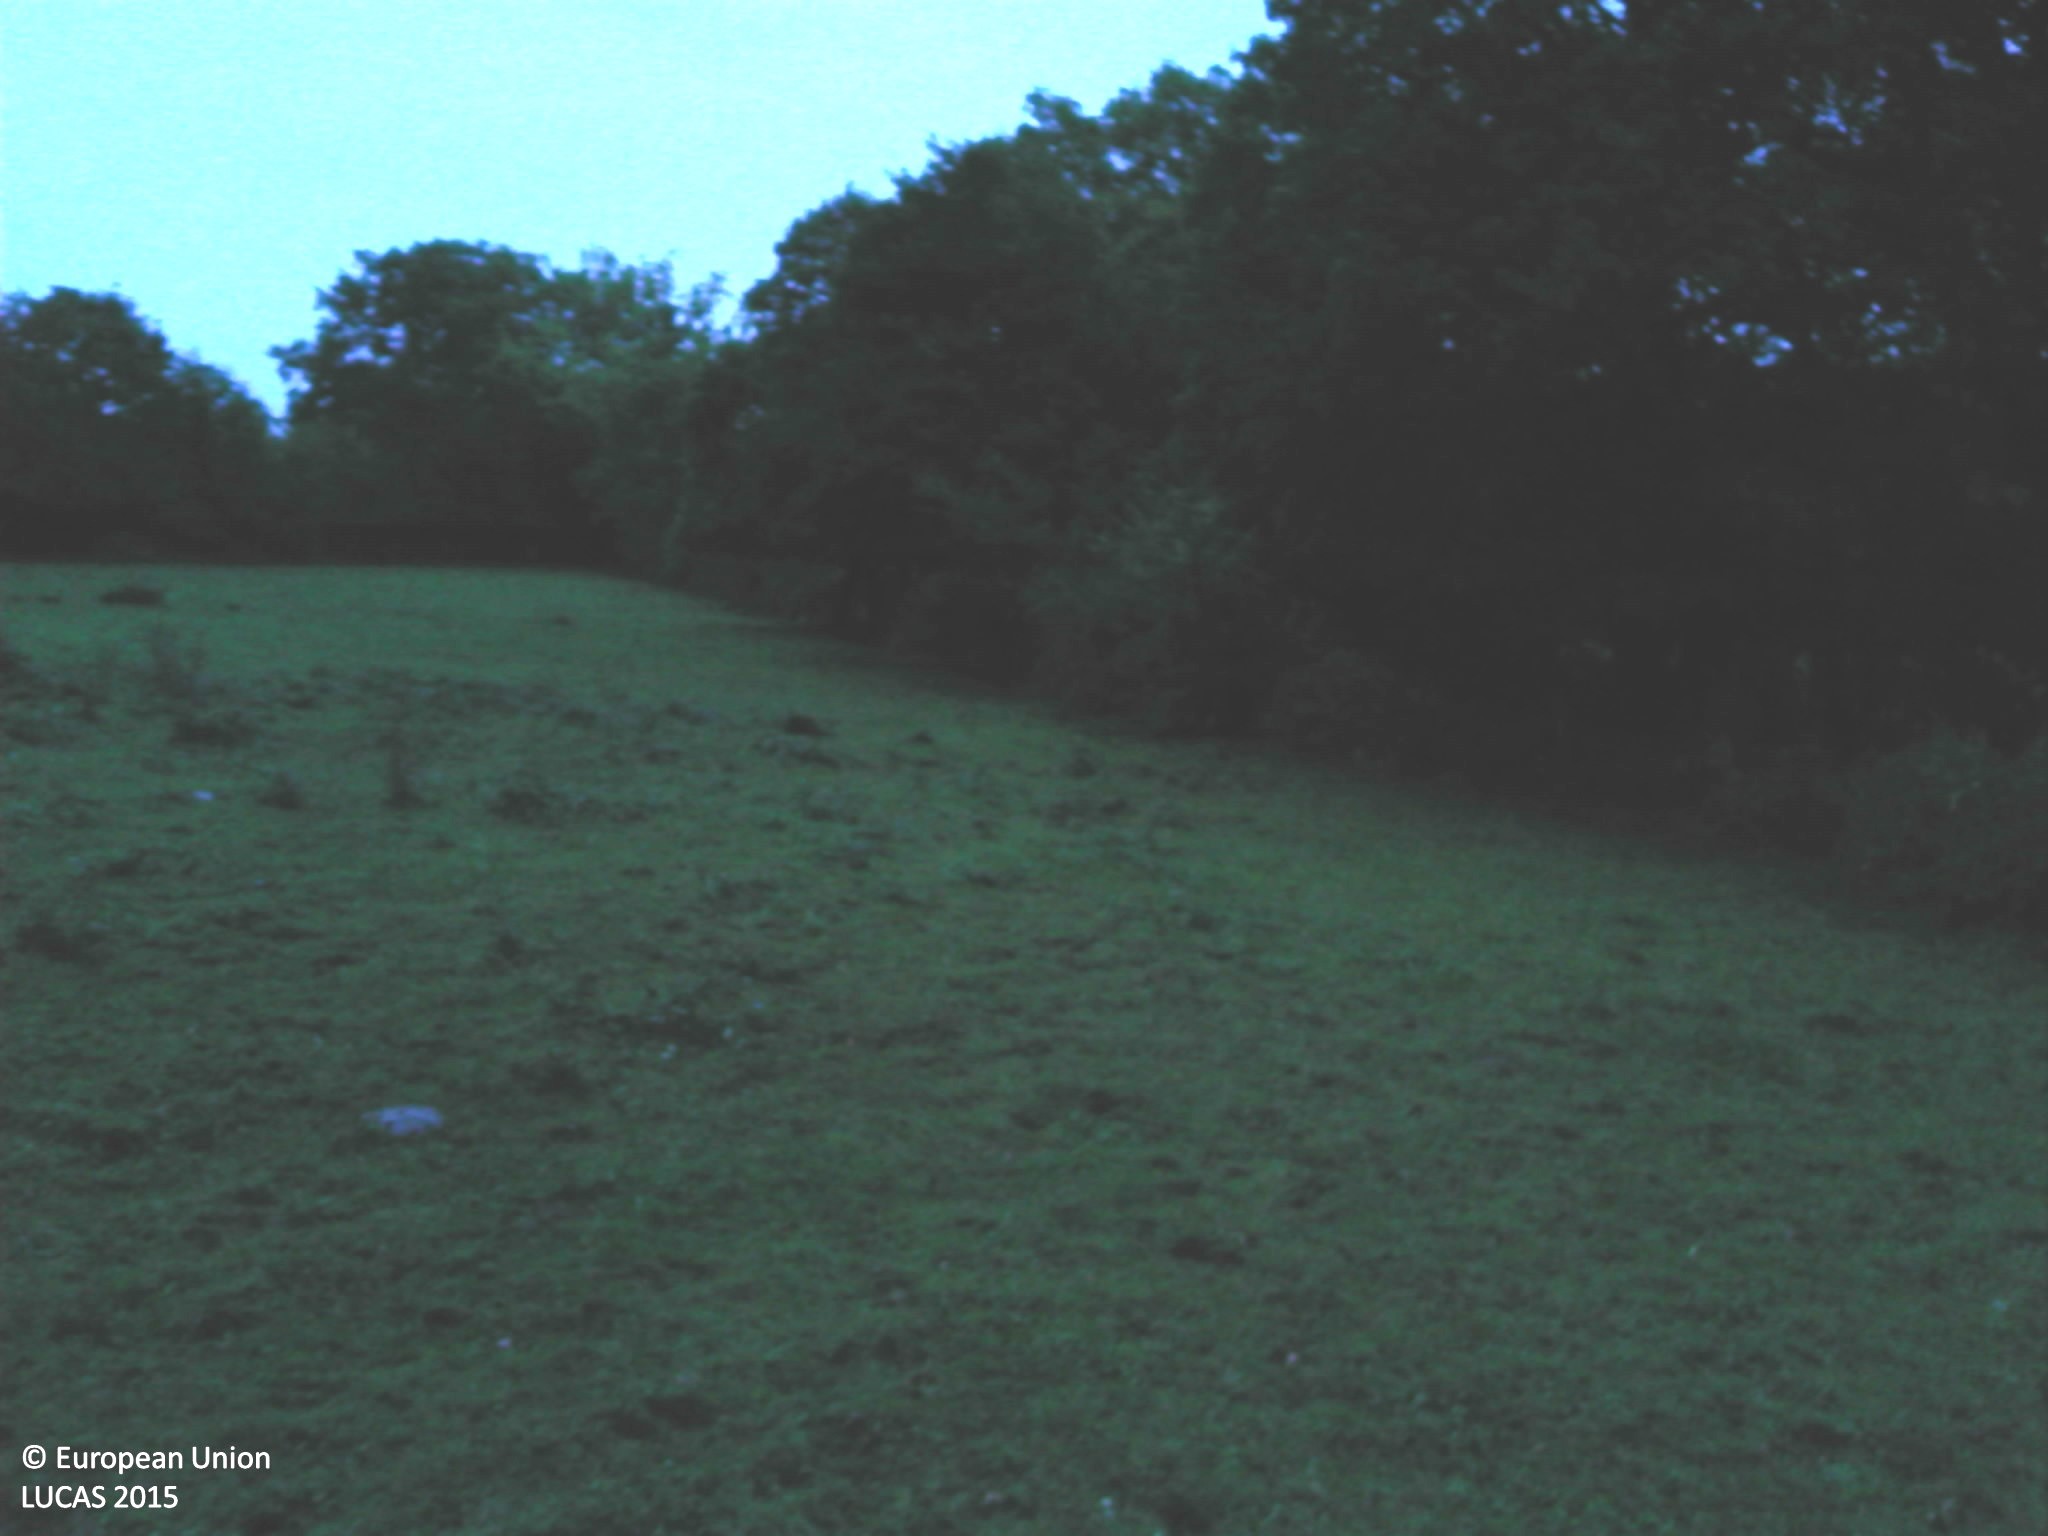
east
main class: Grassland
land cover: Grassland without tree/shrub cover
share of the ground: 50 - 75 %
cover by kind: herbaceous plants 70 %, unconsolidated bare surface 30 %
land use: Agriculture (excluding fallow land and kitchen gardens)
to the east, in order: Grassland without tree/shrub cover; Fences; Abandoned hedges; Grass margins; Paved roads, cycling and walking lanes; Grass margins; Broadleaved woodland; Fences; Grassland without tree/shrub cover; Fences; Abandoned hedges; Fences; Grassland without tree/shrub cover; Fences; Abandoned hedges; Spontaneously vegetated surfaces; Tracks; Grass margins; Ditches and canals; Broadleaved woodland; Fences; Grassland without tree/shrub cover
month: September
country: FR
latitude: 46.5457
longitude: 1.6047
